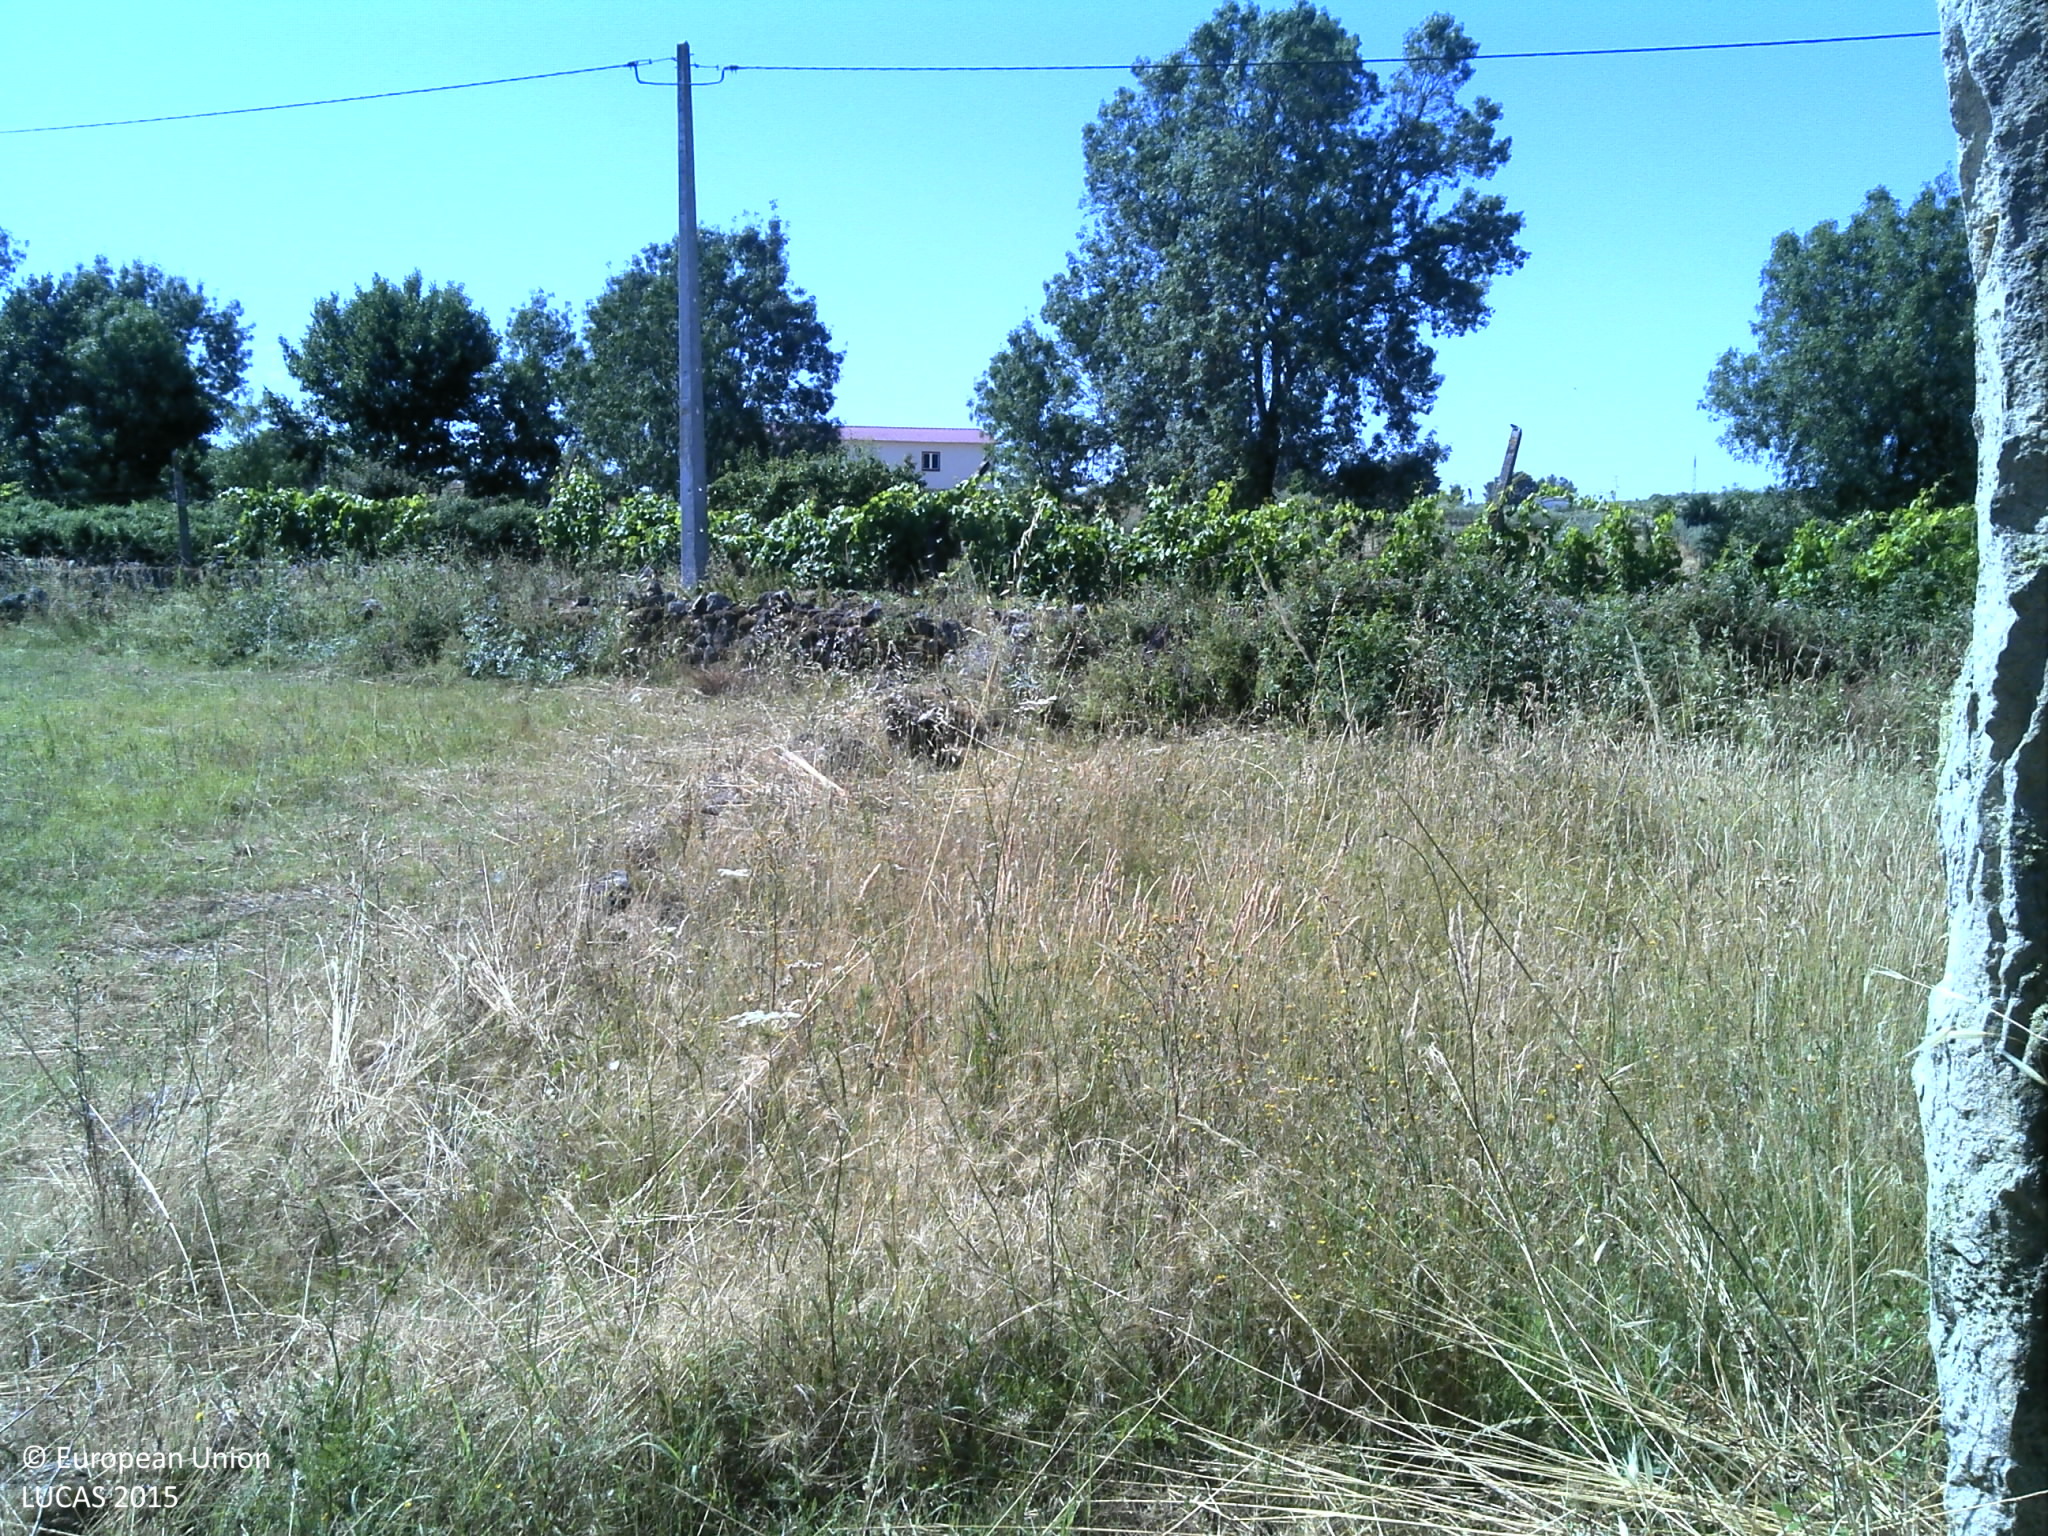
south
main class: Grassland
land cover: Grassland without tree/shrub cover
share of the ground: 50 - 75 %
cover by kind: herbaceous plants 65 %, unconsolidated bare surface 35 %
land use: Agriculture (excluding fallow land and kitchen gardens)
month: June
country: PT
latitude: 40.9124
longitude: -7.1951
